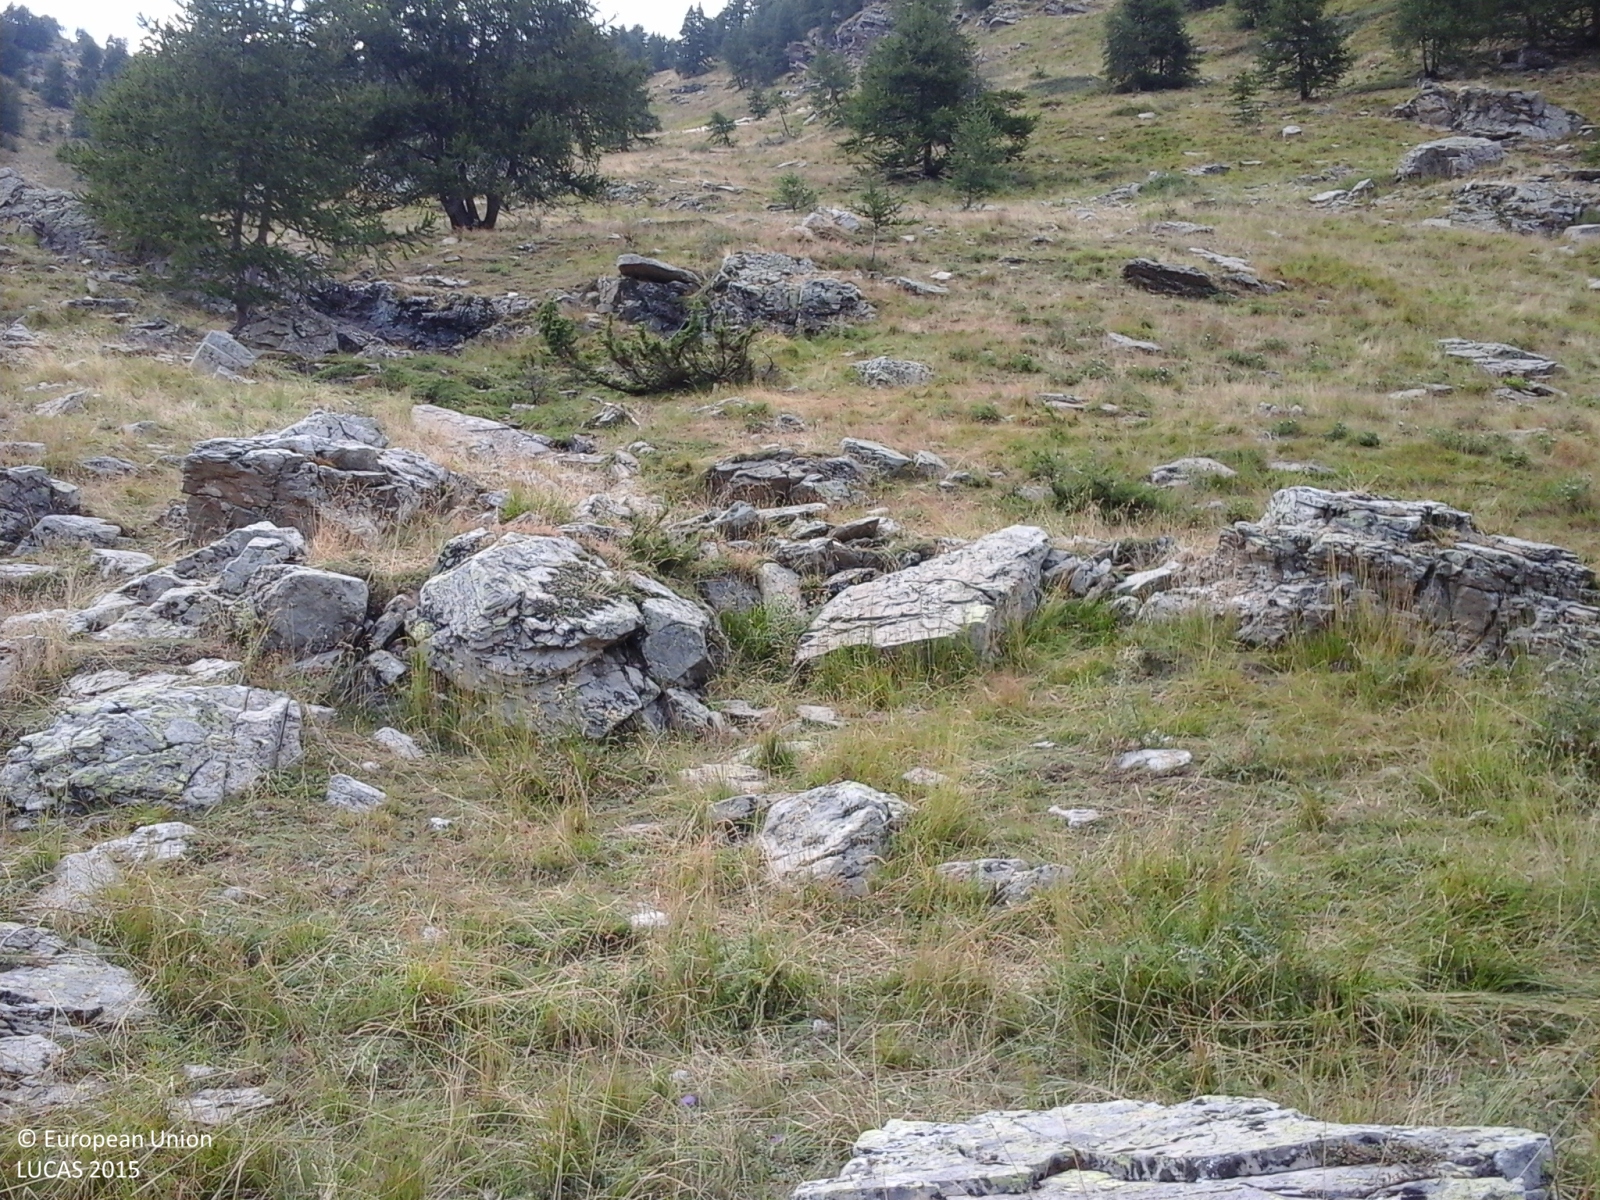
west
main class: Grassland
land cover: Grassland without tree/shrub cover
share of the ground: > 75 %
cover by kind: herbaceous plants 80 %, consolidated bare surface 20 %
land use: Agriculture (excluding fallow land and kitchen gardens)
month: August
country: IT
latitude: 44.0909
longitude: 7.7196
